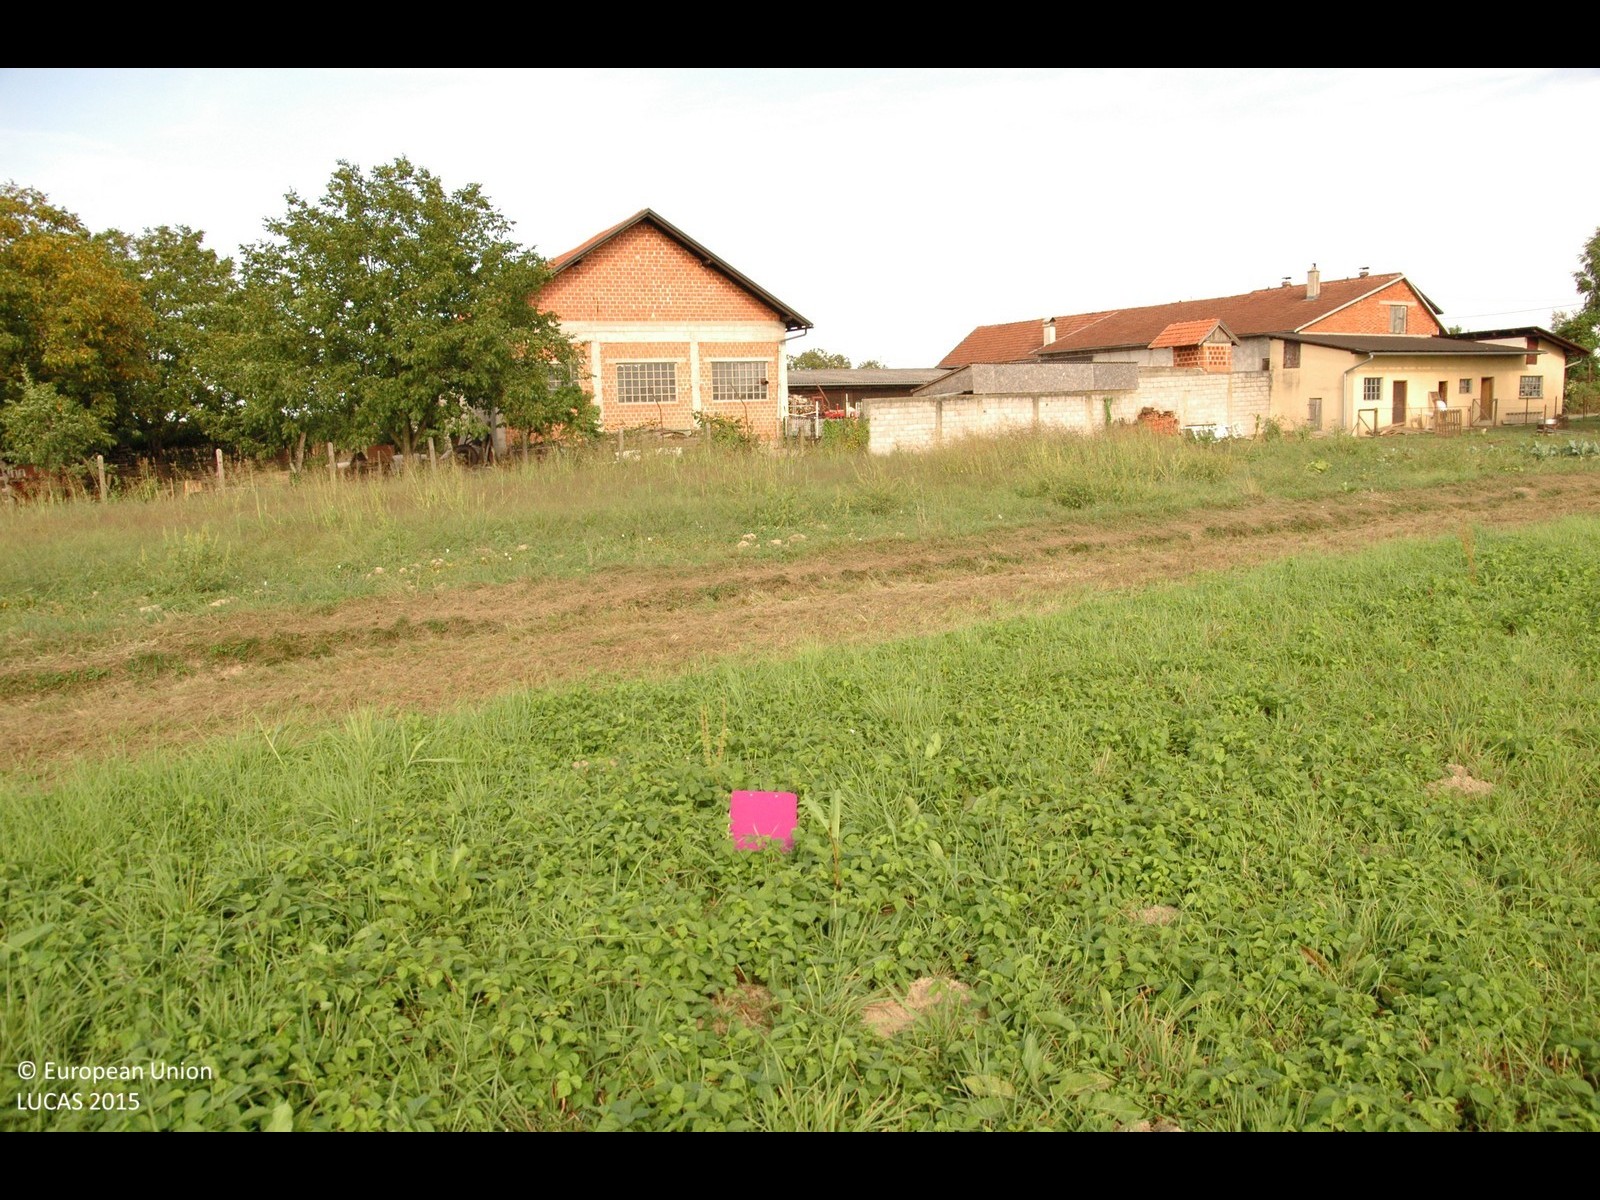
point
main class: Grassland
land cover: Grassland without tree/shrub cover
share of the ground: > 75 %
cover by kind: herbaceous plants 100 %
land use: Agriculture (excluding fallow land and kitchen gardens)
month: September
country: HR
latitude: 45.7176
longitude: 15.9201
